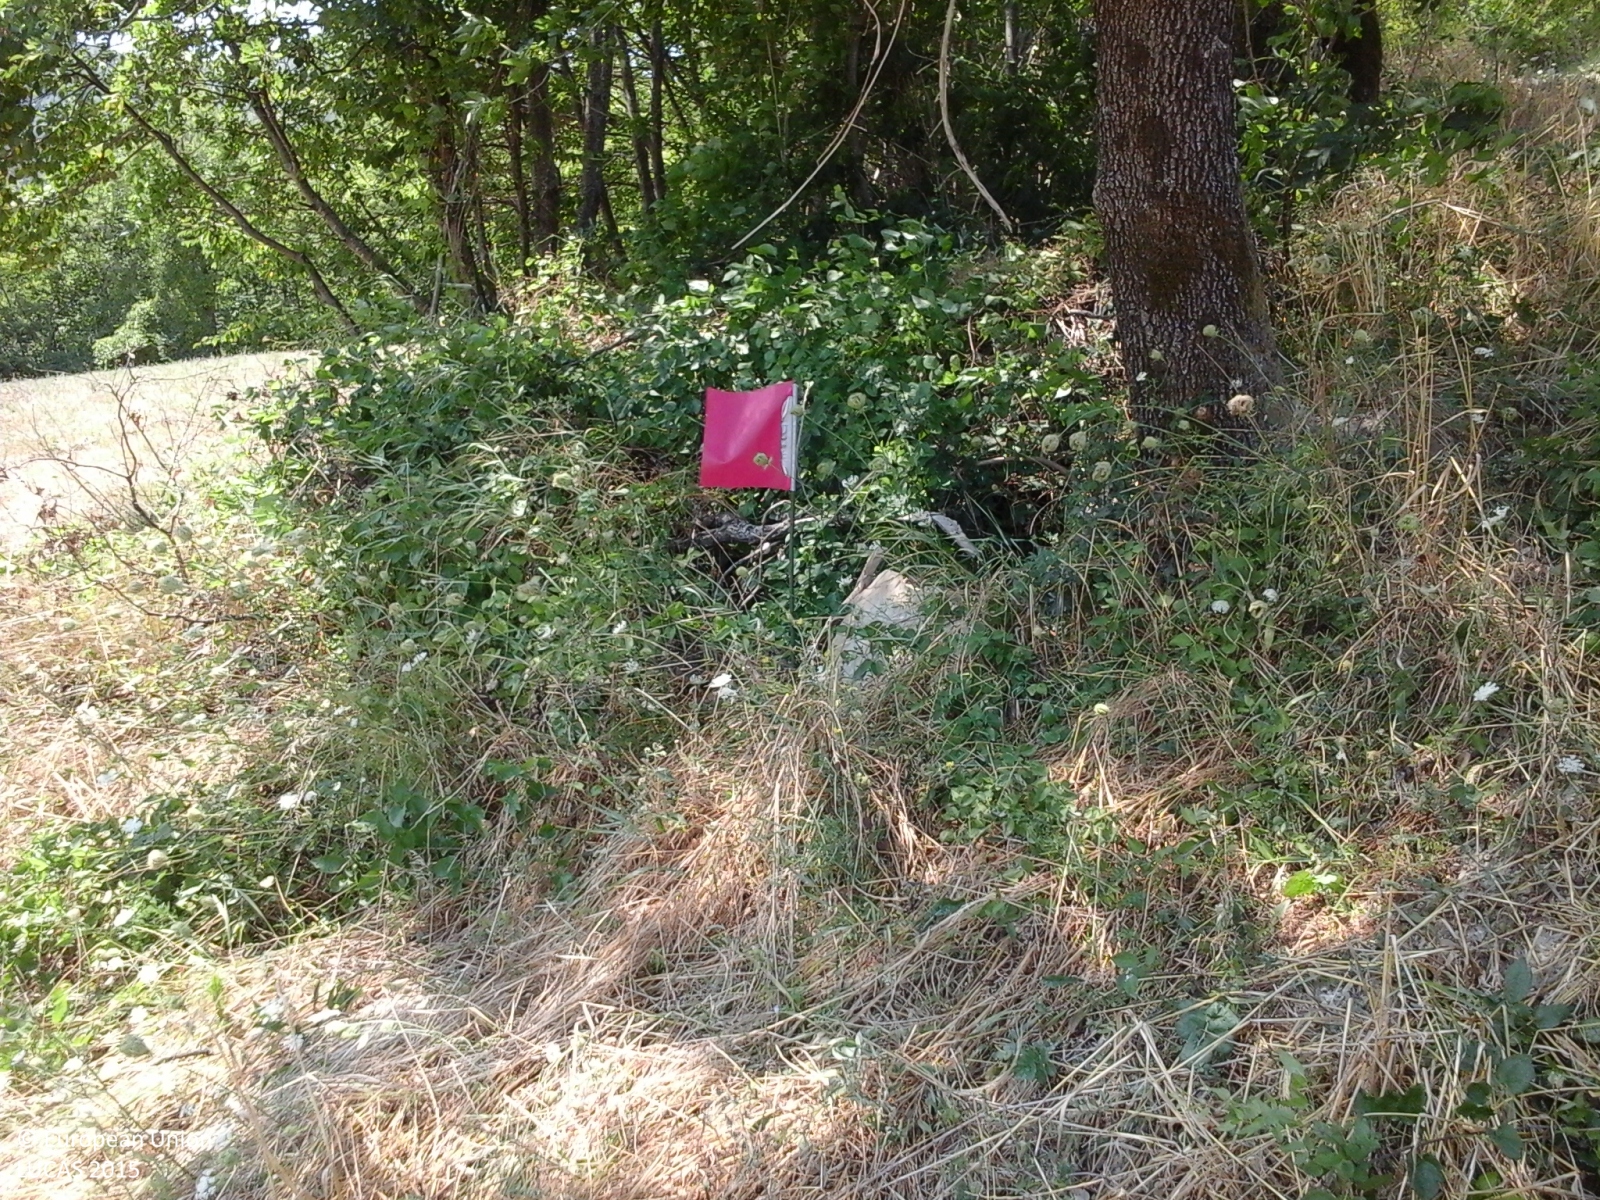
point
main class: Woodland
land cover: Broadleaved woodland
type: thermophilous deciduous forest
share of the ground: > 75 %
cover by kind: broadleaved forest trees 100 %
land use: Forestry
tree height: > 5 m
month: August
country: IT
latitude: 43.6942
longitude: 12.2648
